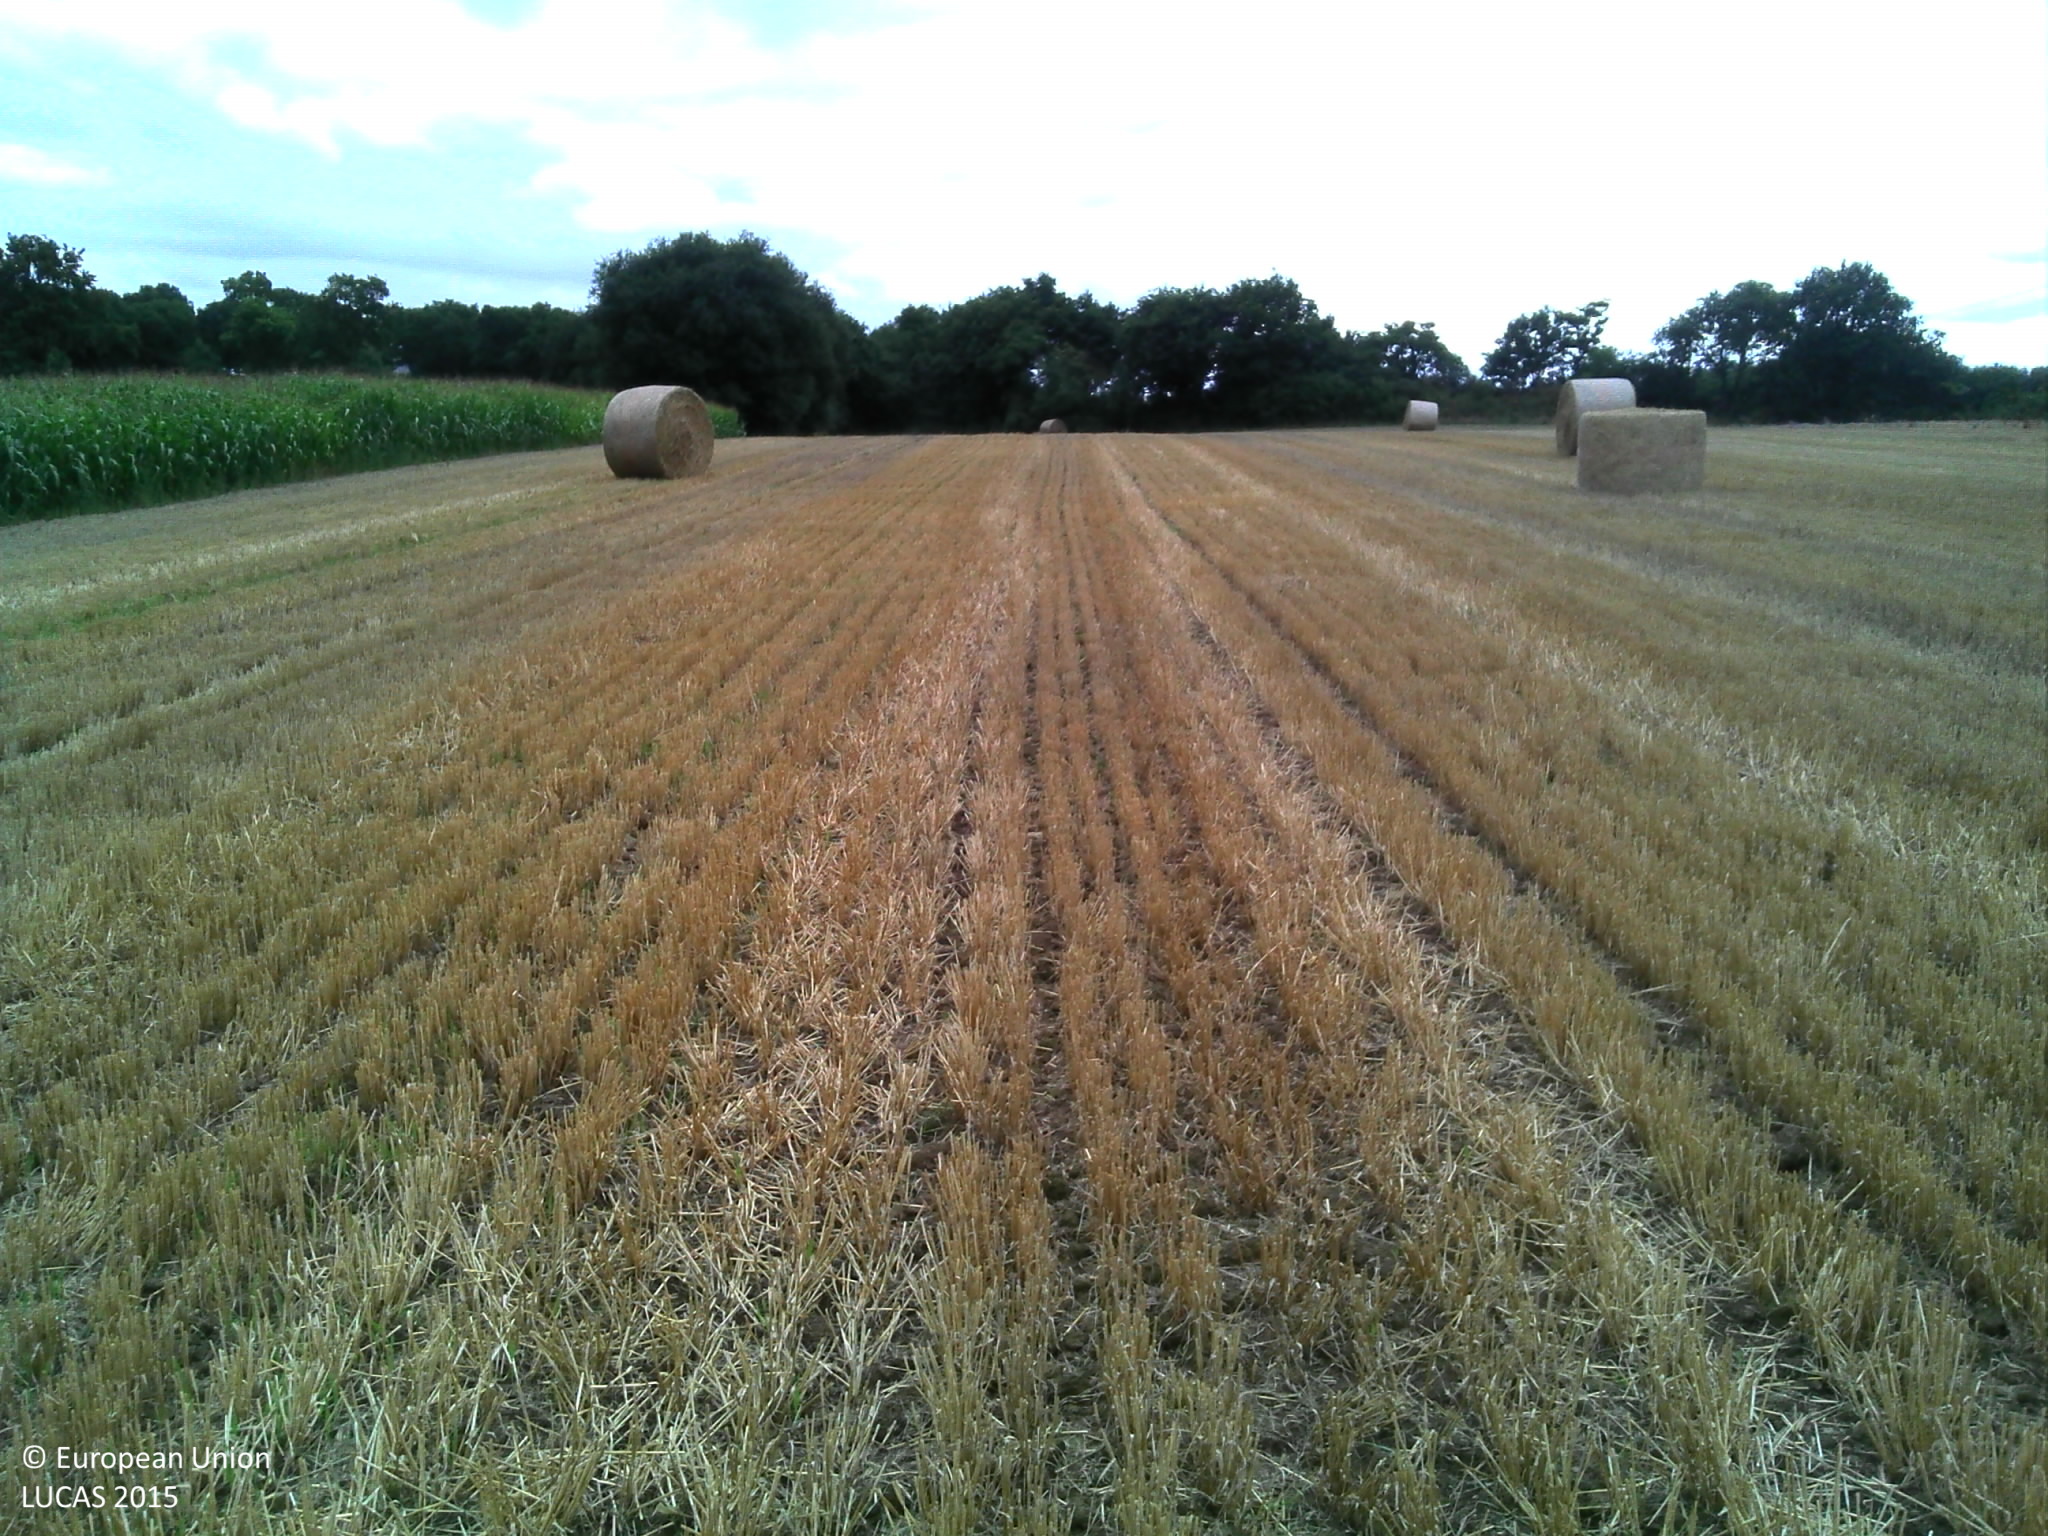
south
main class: Cropland
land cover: Barley
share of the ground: > 75 %
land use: Agriculture (excluding fallow land and kitchen gardens)
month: August
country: FR
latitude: 48.6615
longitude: -3.2307
